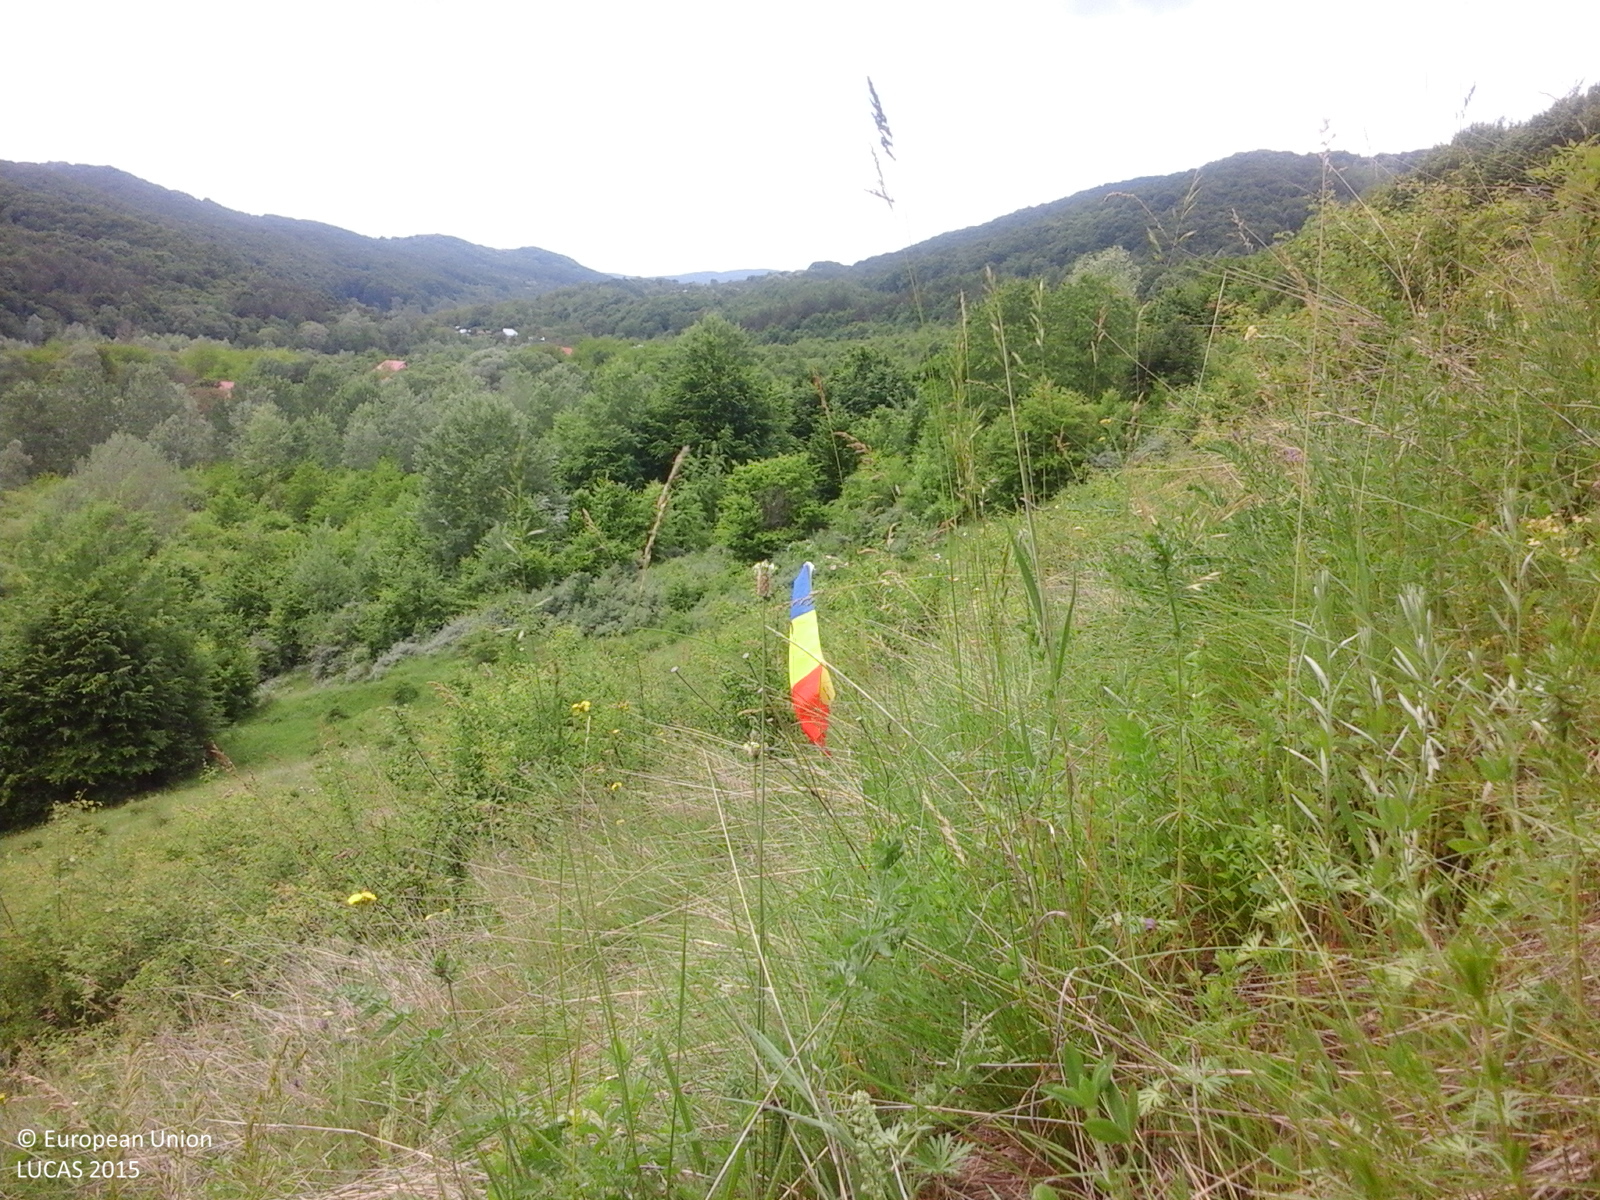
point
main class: Grassland
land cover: Grassland with sparse tree/shrub cover
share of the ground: > 75 %
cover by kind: herbaceous plants 90 %, broadleaved forest trees 5 %, shrubs 5 %
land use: Agriculture (excluding fallow land and kitchen gardens)
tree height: < 5 m
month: May
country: RO
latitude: 45.2650
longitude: 26.2387
